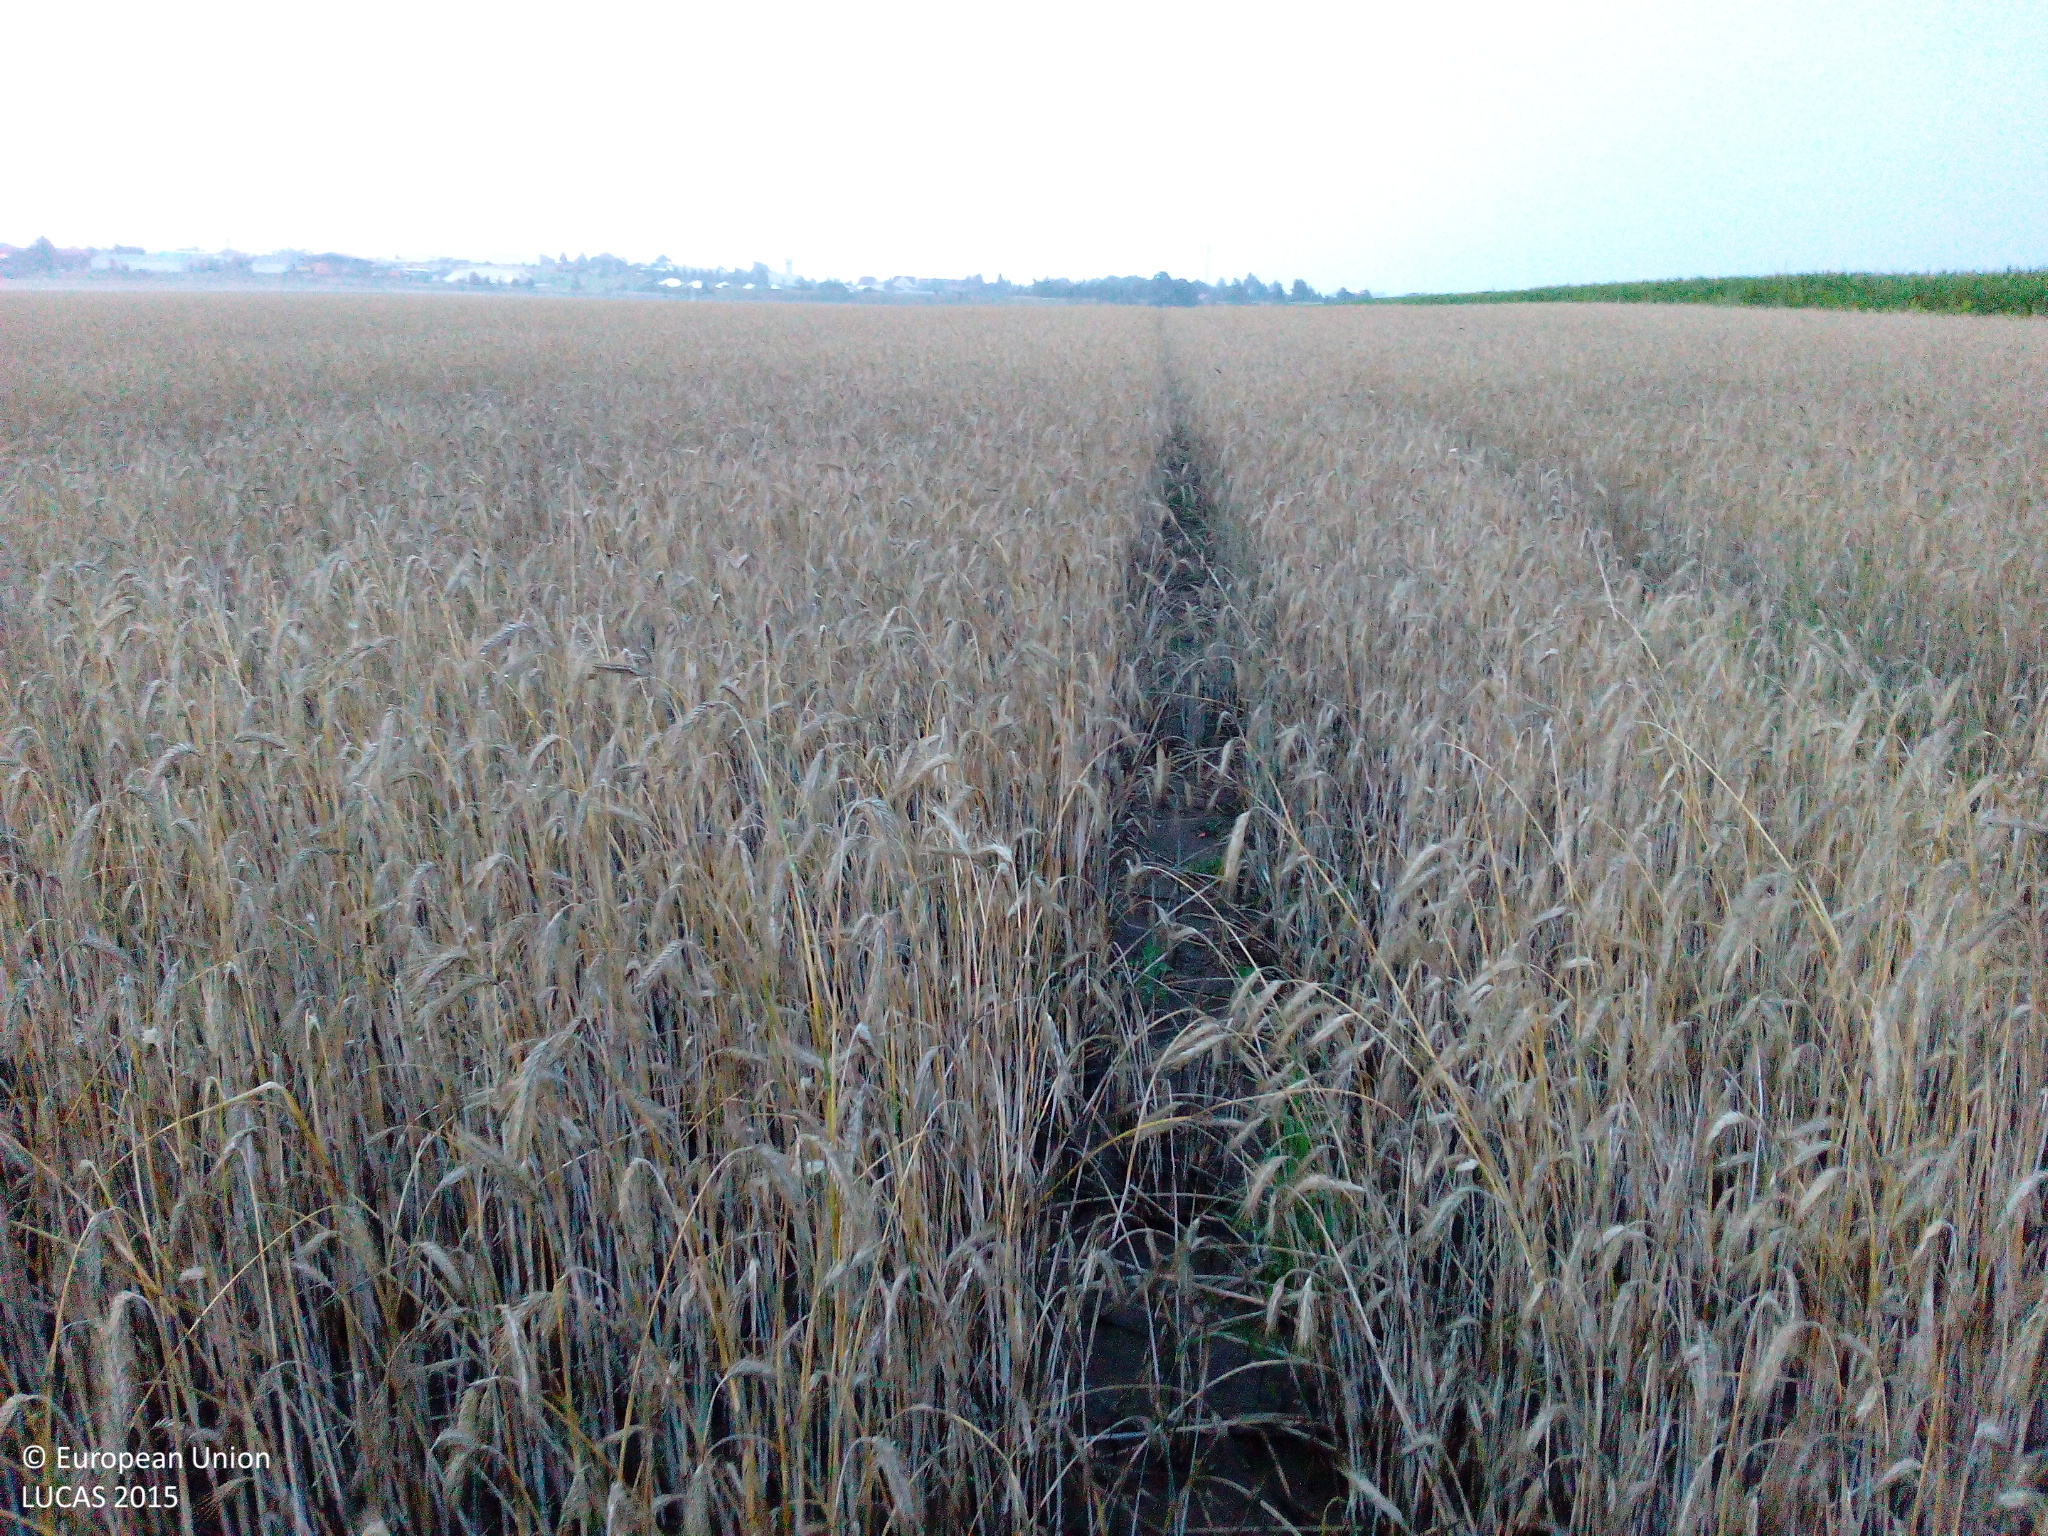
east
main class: Cropland
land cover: Rye
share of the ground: > 75 %
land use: Agriculture (excluding fallow land and kitchen gardens)
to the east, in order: Rye
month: July
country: DE
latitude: 53.1617
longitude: 12.4373
